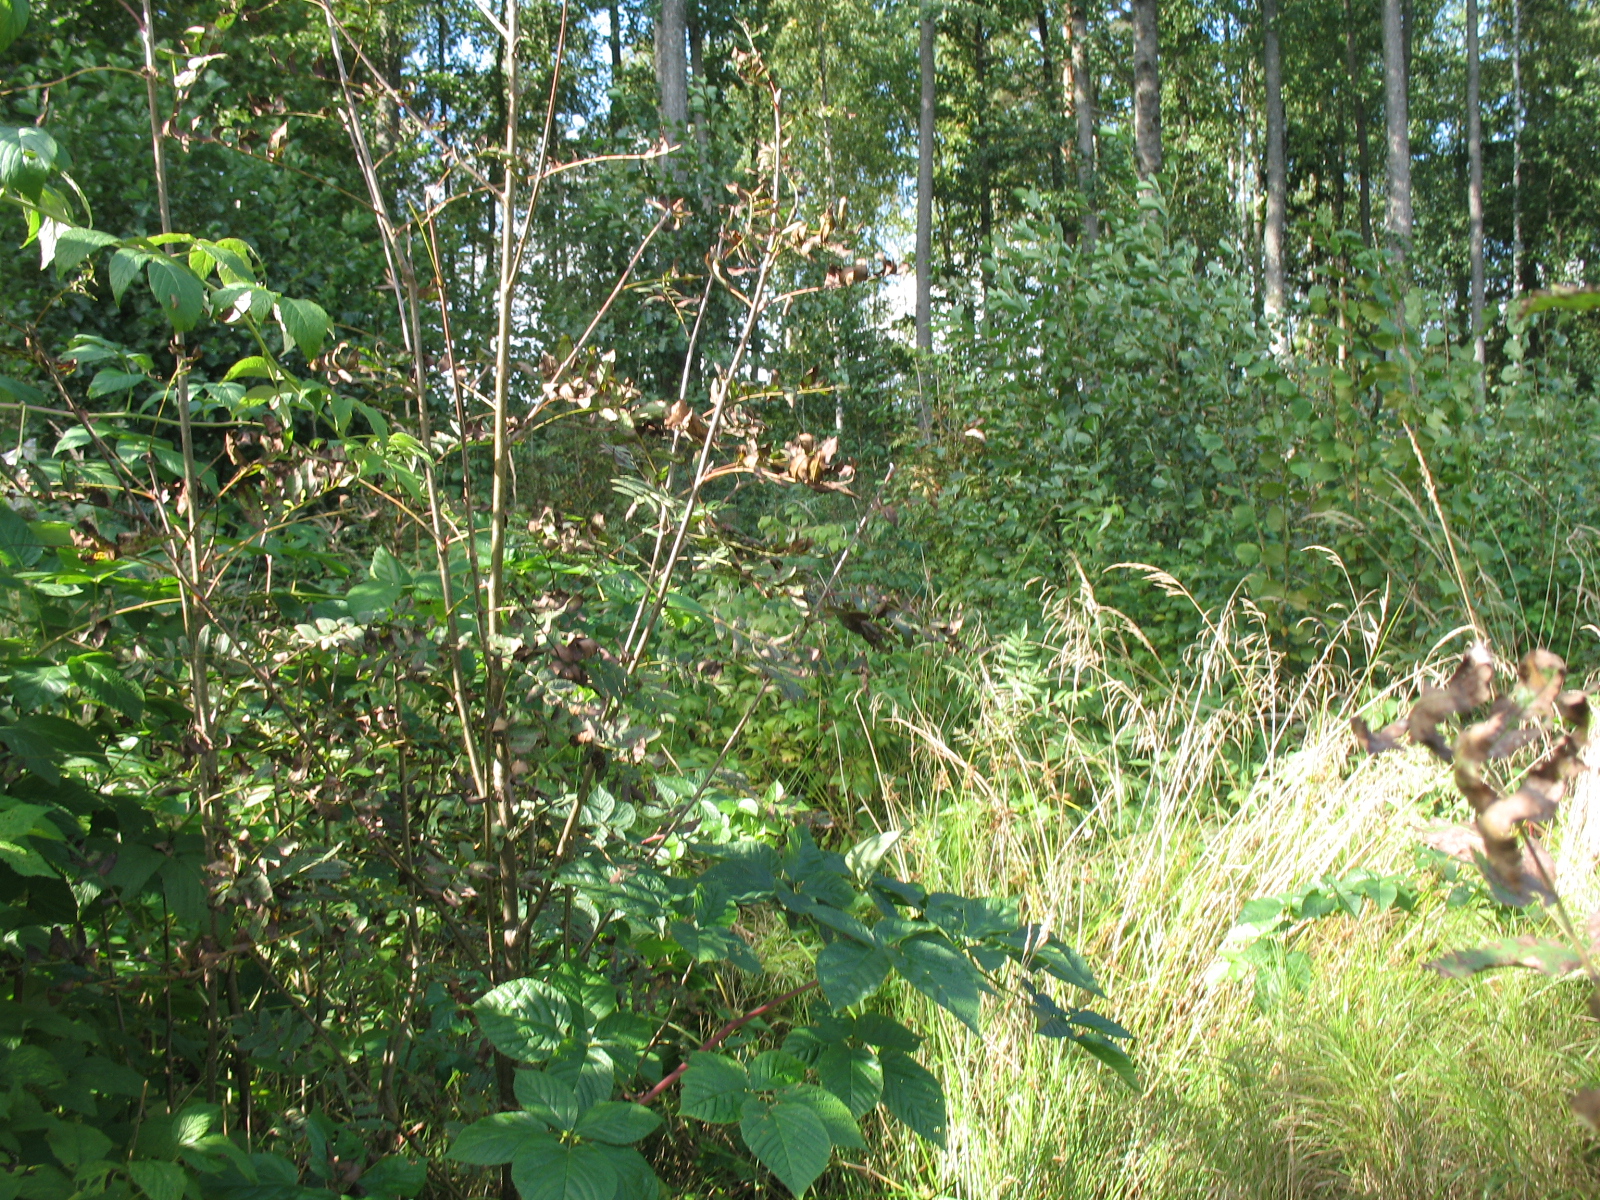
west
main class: Woodland
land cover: Broadleaved woodland
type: non-riverine alder, birch or aspen forest
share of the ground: 50 - 75 %
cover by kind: broadleaved forest trees 60 %, herbaceous plants 30 %, shrubs 10 %
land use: Forestry
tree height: < 5 m
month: September
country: LV
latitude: 56.1960
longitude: 25.9105
